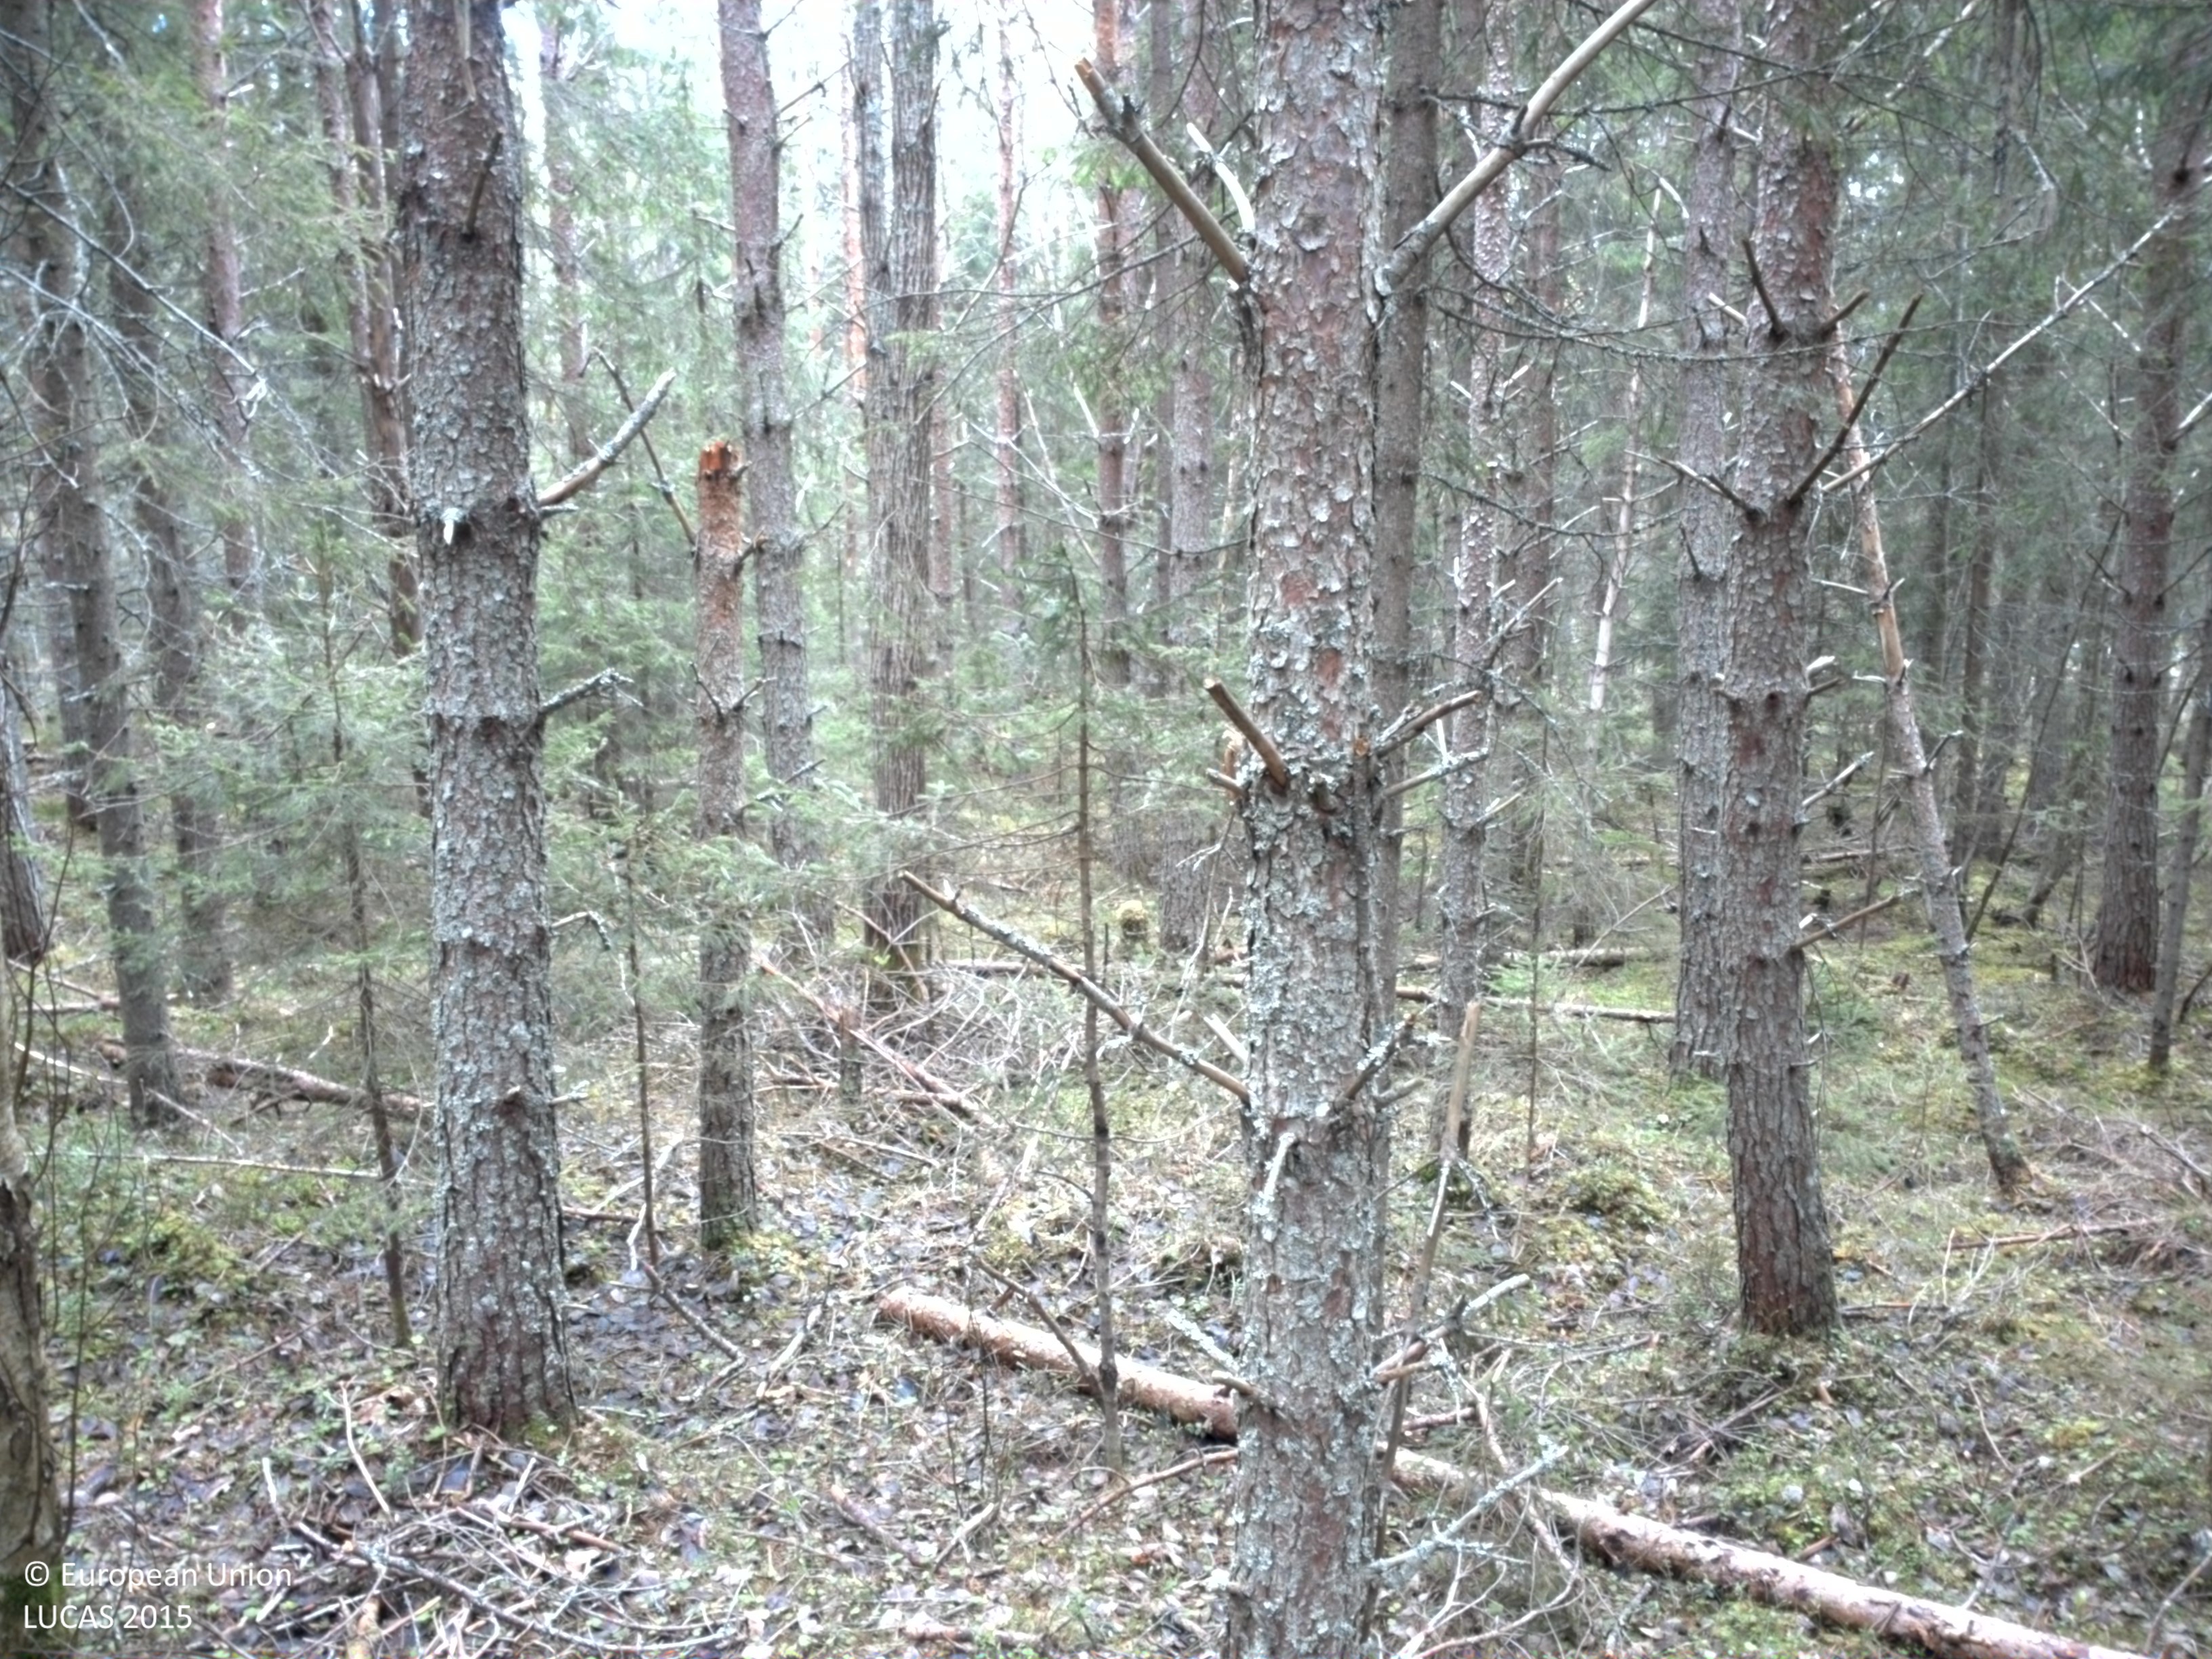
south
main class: Woodland
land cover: Pine dominated mixed woodland
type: boreal forest
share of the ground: > 75 %
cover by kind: coniferous forest trees 60 %, broadleaved forest trees 20 %, lichens and mosses 10 %, shrubs 5 %, herbaceous plants 5 %
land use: Forestry
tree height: > 5 m
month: June
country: SE
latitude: 63.4819
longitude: 13.9347
